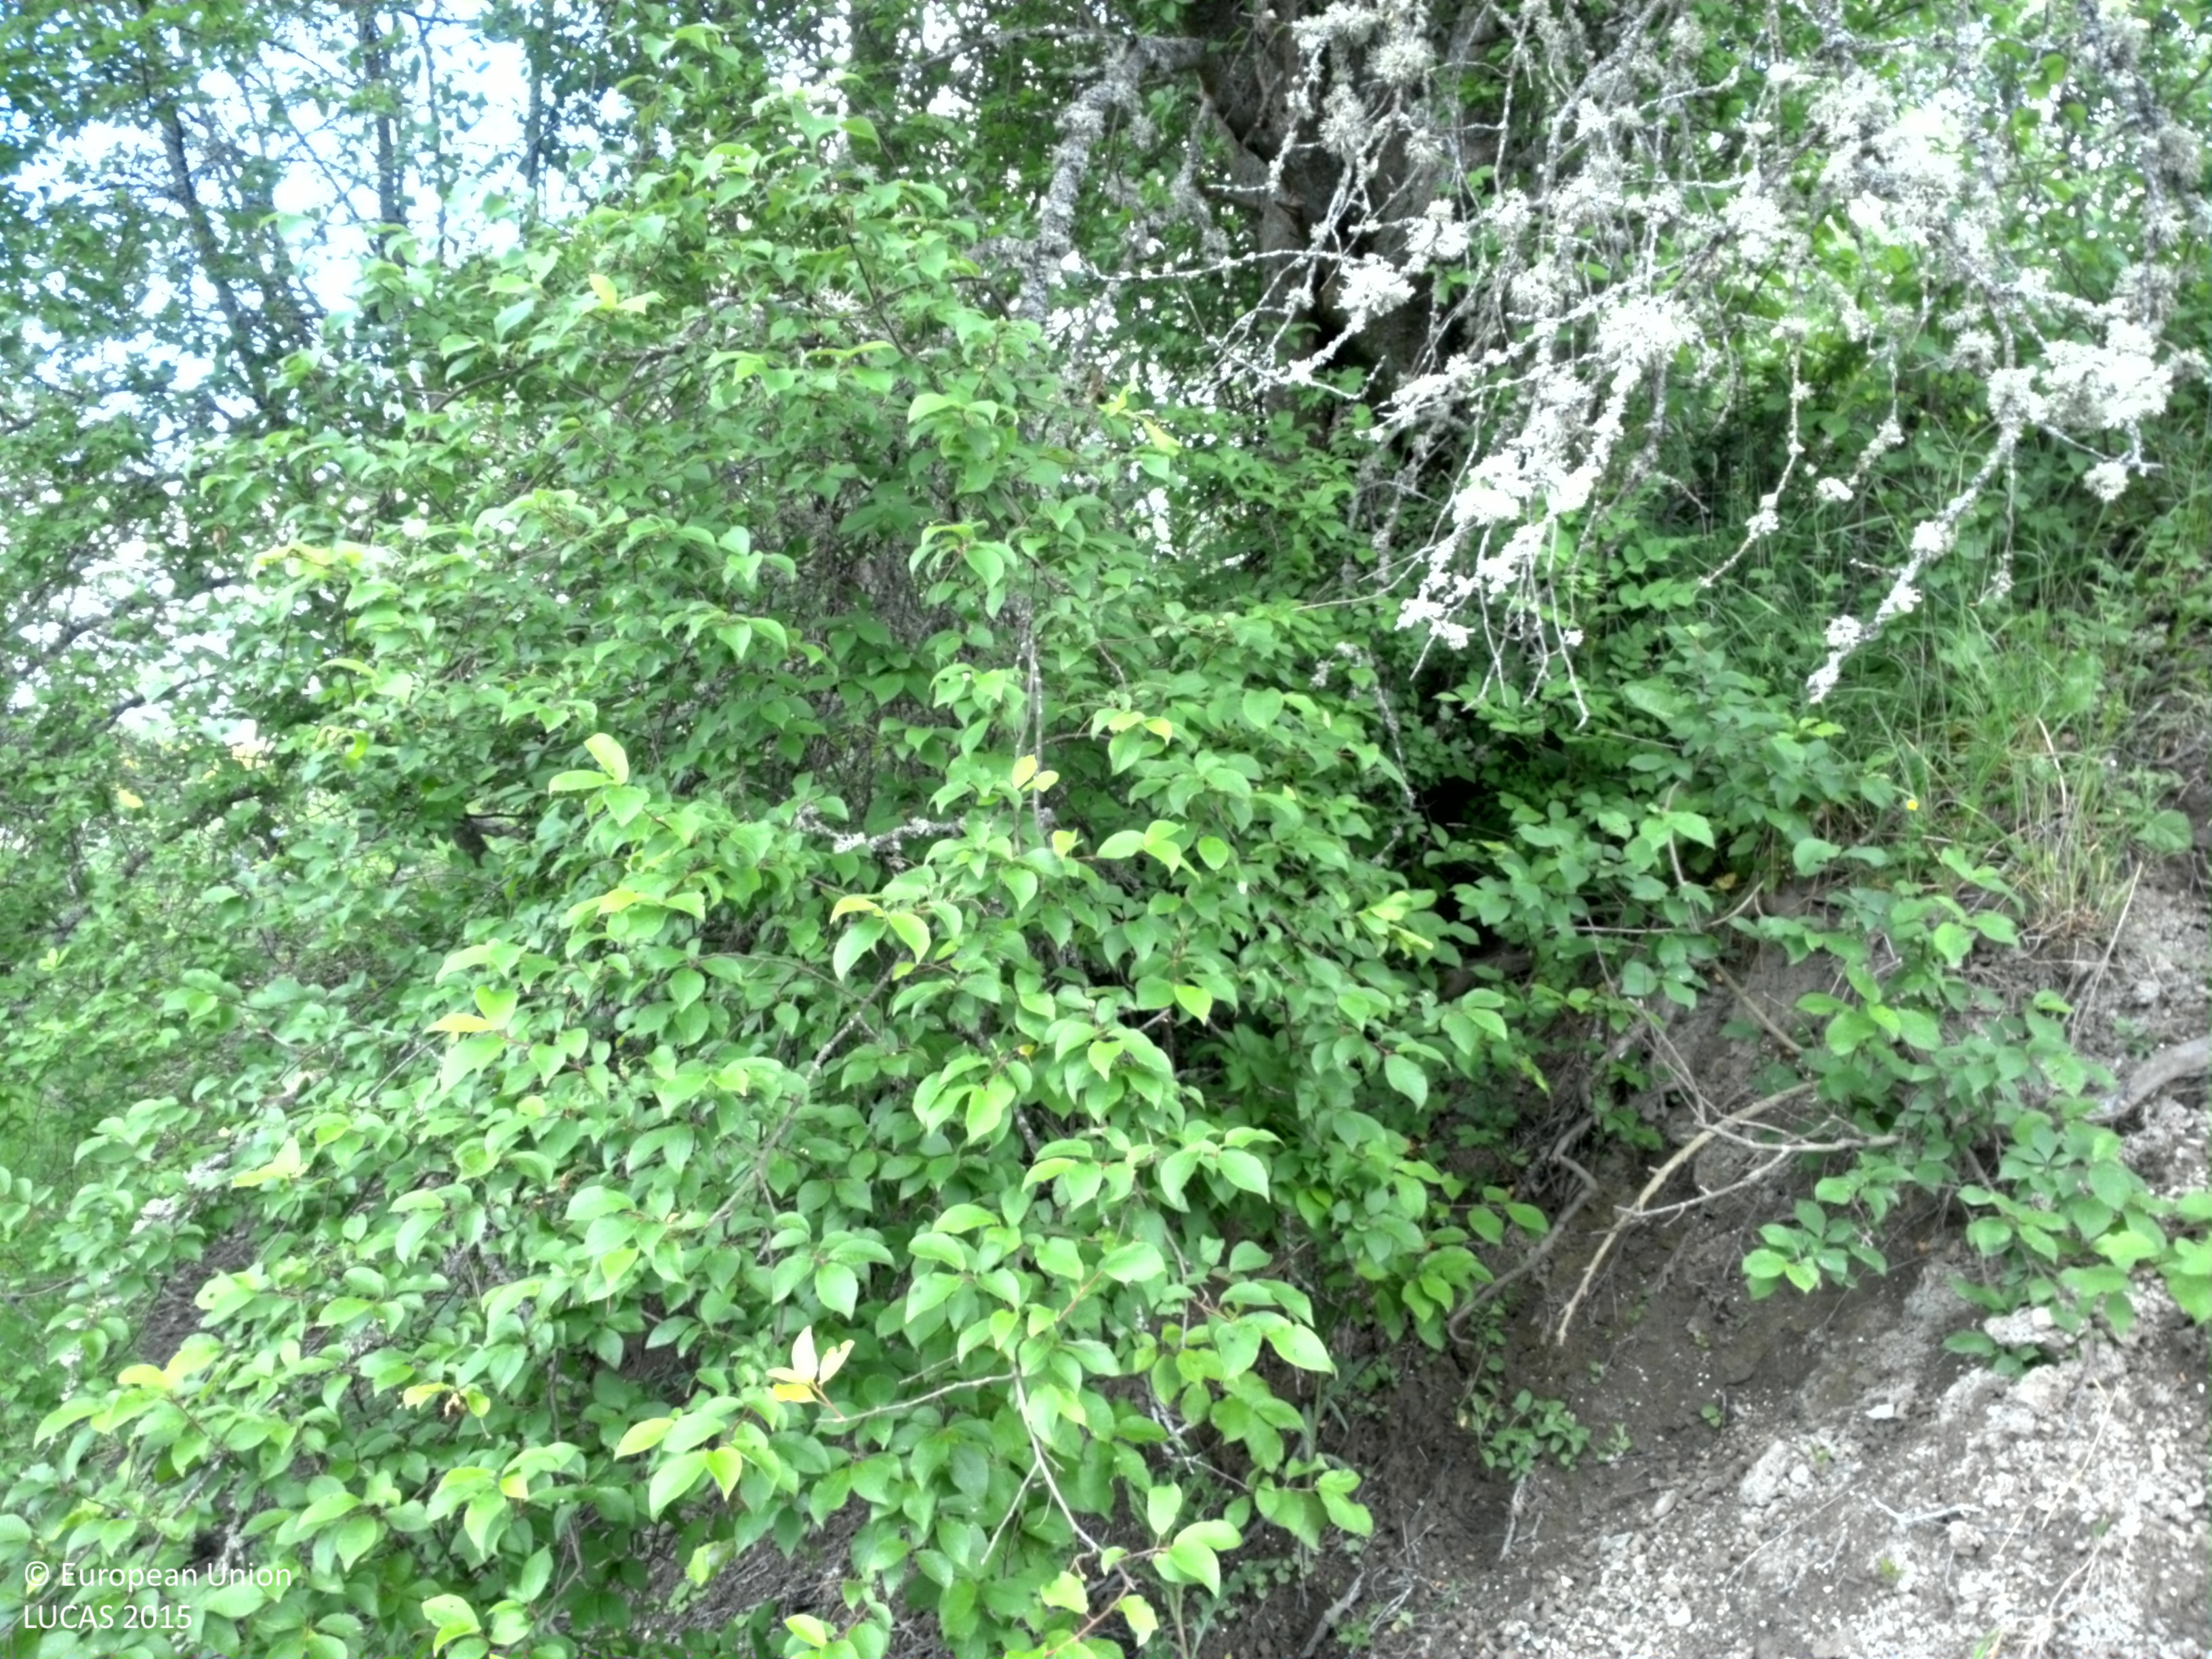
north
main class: Grassland
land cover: Grassland without tree/shrub cover
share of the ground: > 75 %
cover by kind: herbaceous plants 95 %, shrubs 5 %
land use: Agriculture (excluding fallow land and kitchen gardens)
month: June
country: SE
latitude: 59.9254
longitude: 17.5253
